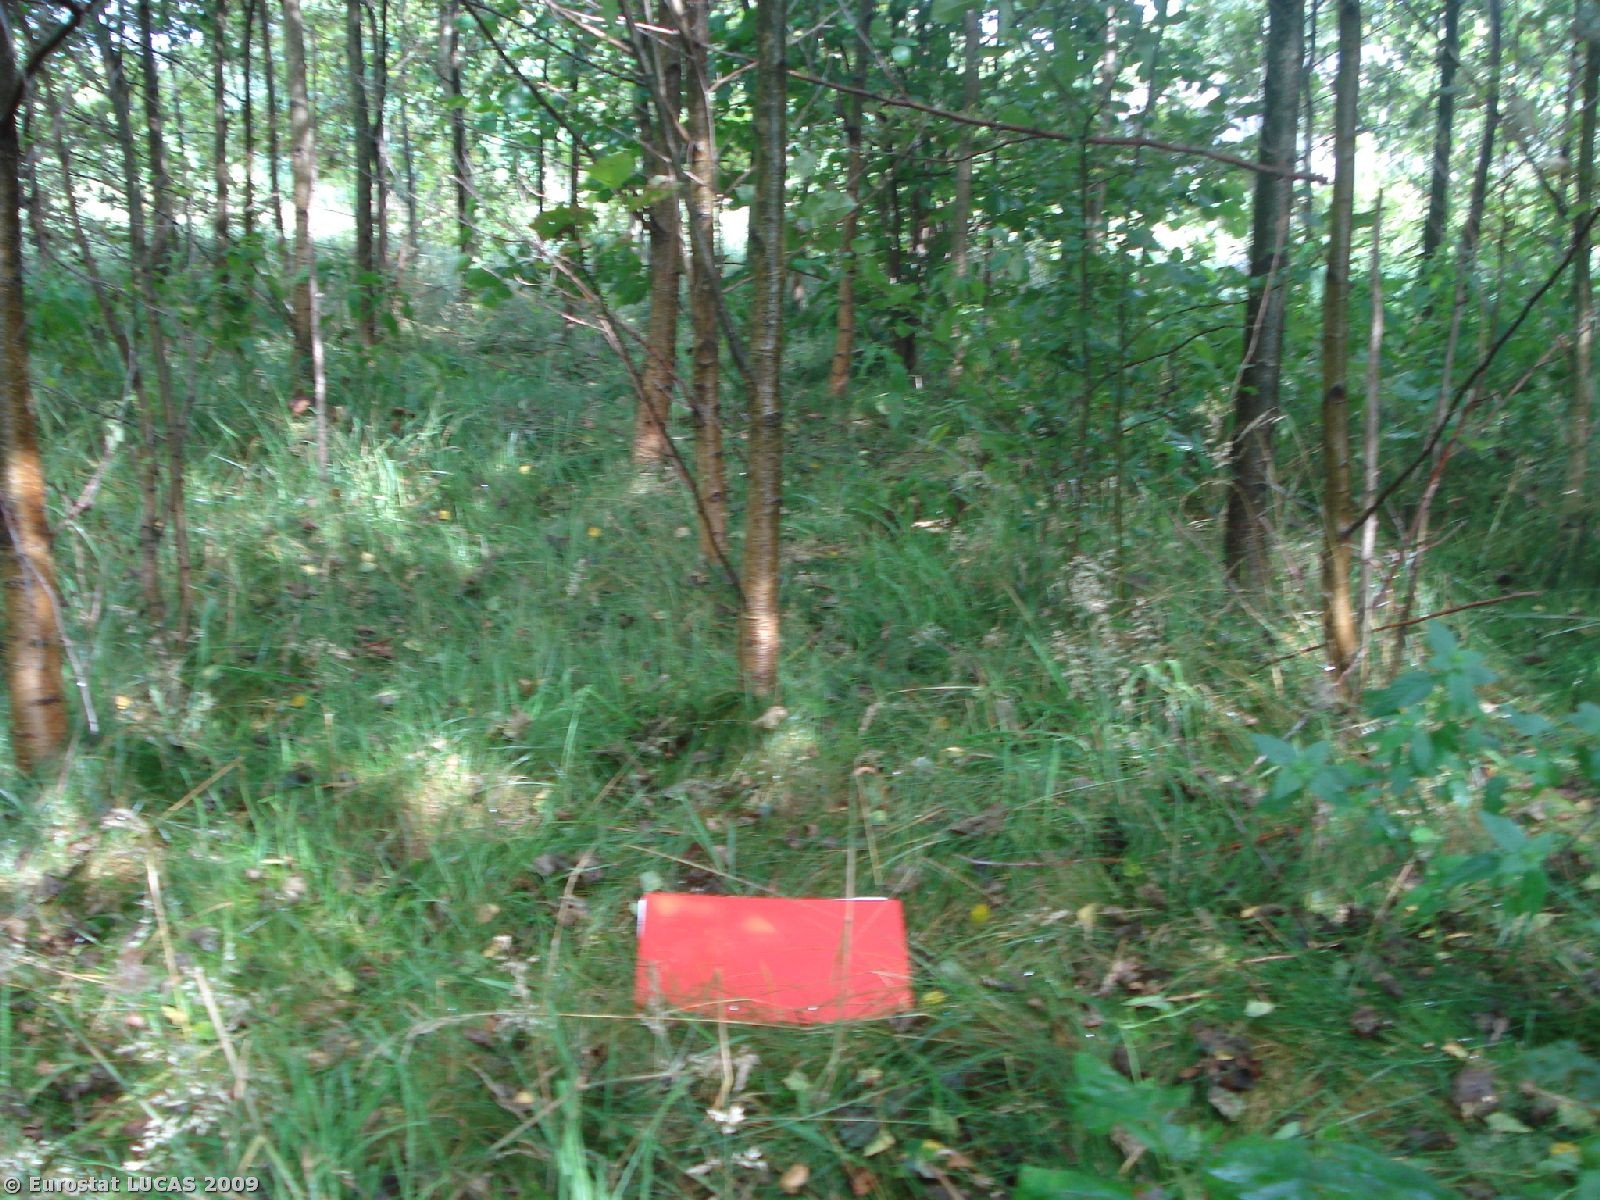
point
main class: Woodland
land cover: Broadleaved woodland
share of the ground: 50 - 75 %
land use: Agriculture (excluding fallow land and kitchen gardens)
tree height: > 5 m
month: July
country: PL
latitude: 51.3236
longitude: 23.0630
